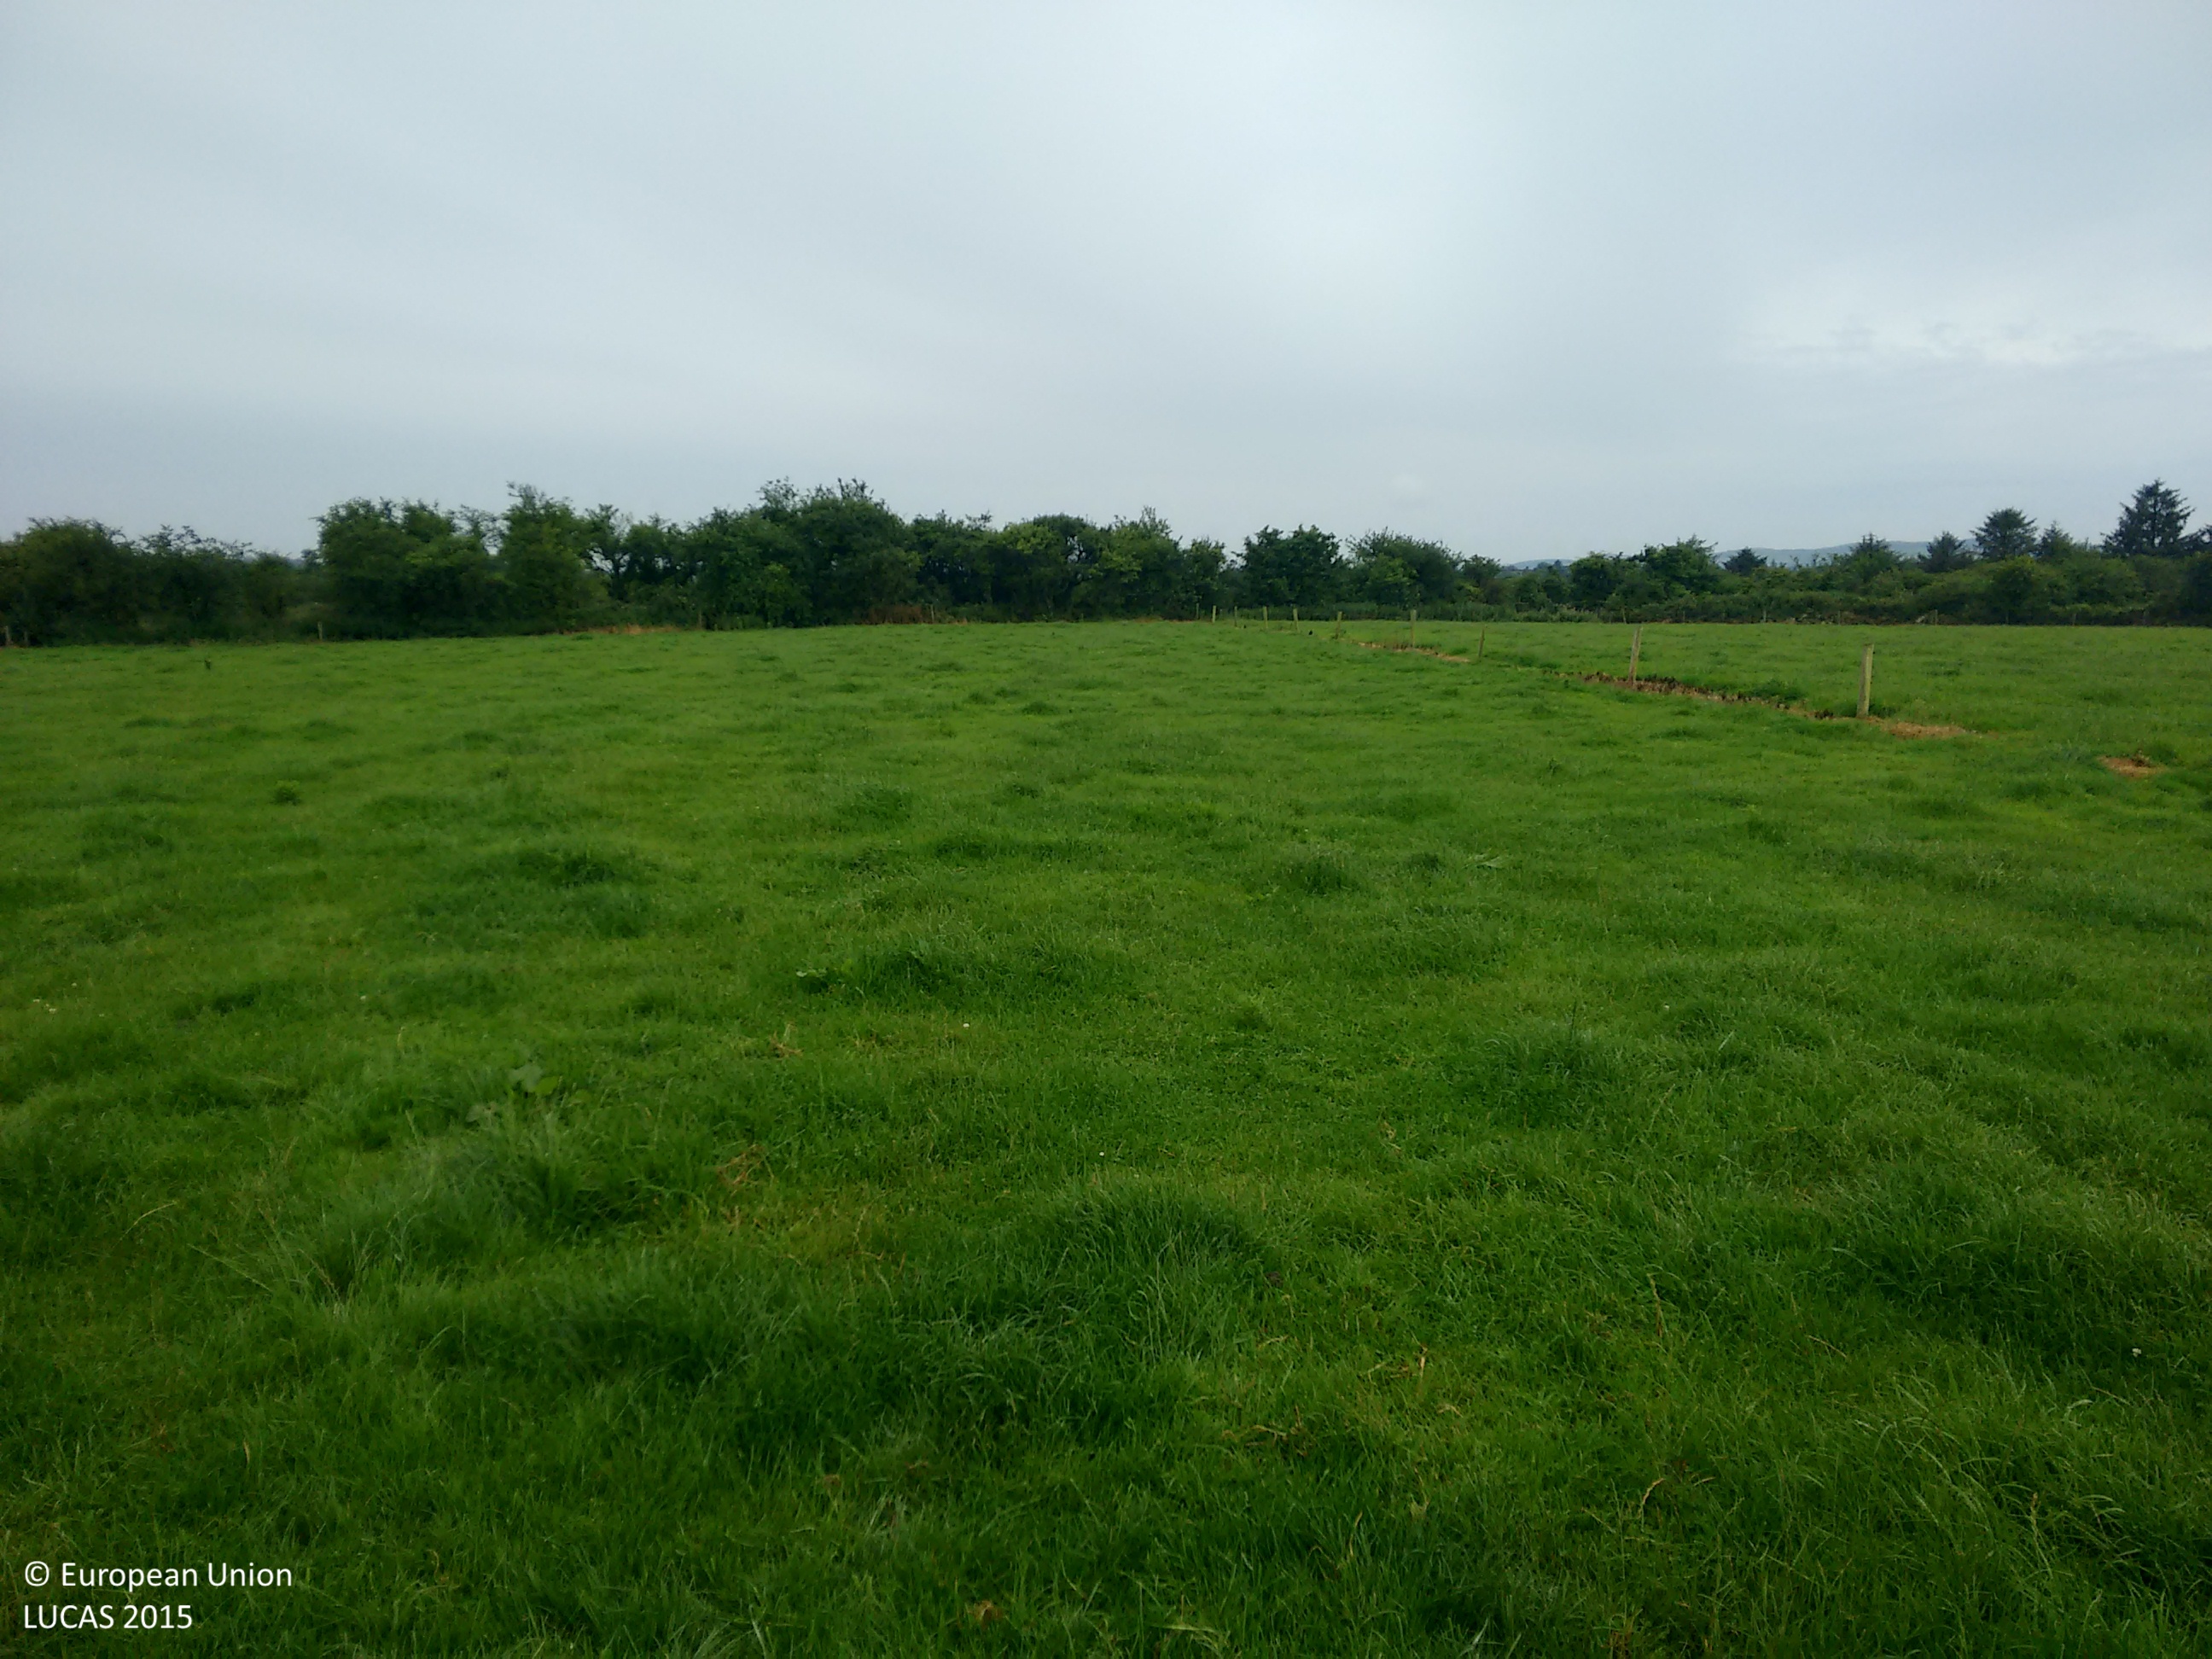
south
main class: Grassland
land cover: Grassland without tree/shrub cover
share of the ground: > 75 %
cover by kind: herbaceous plants 100 %
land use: Agriculture (excluding fallow land and kitchen gardens)
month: July
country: IE
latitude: 52.4382
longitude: -7.1679
